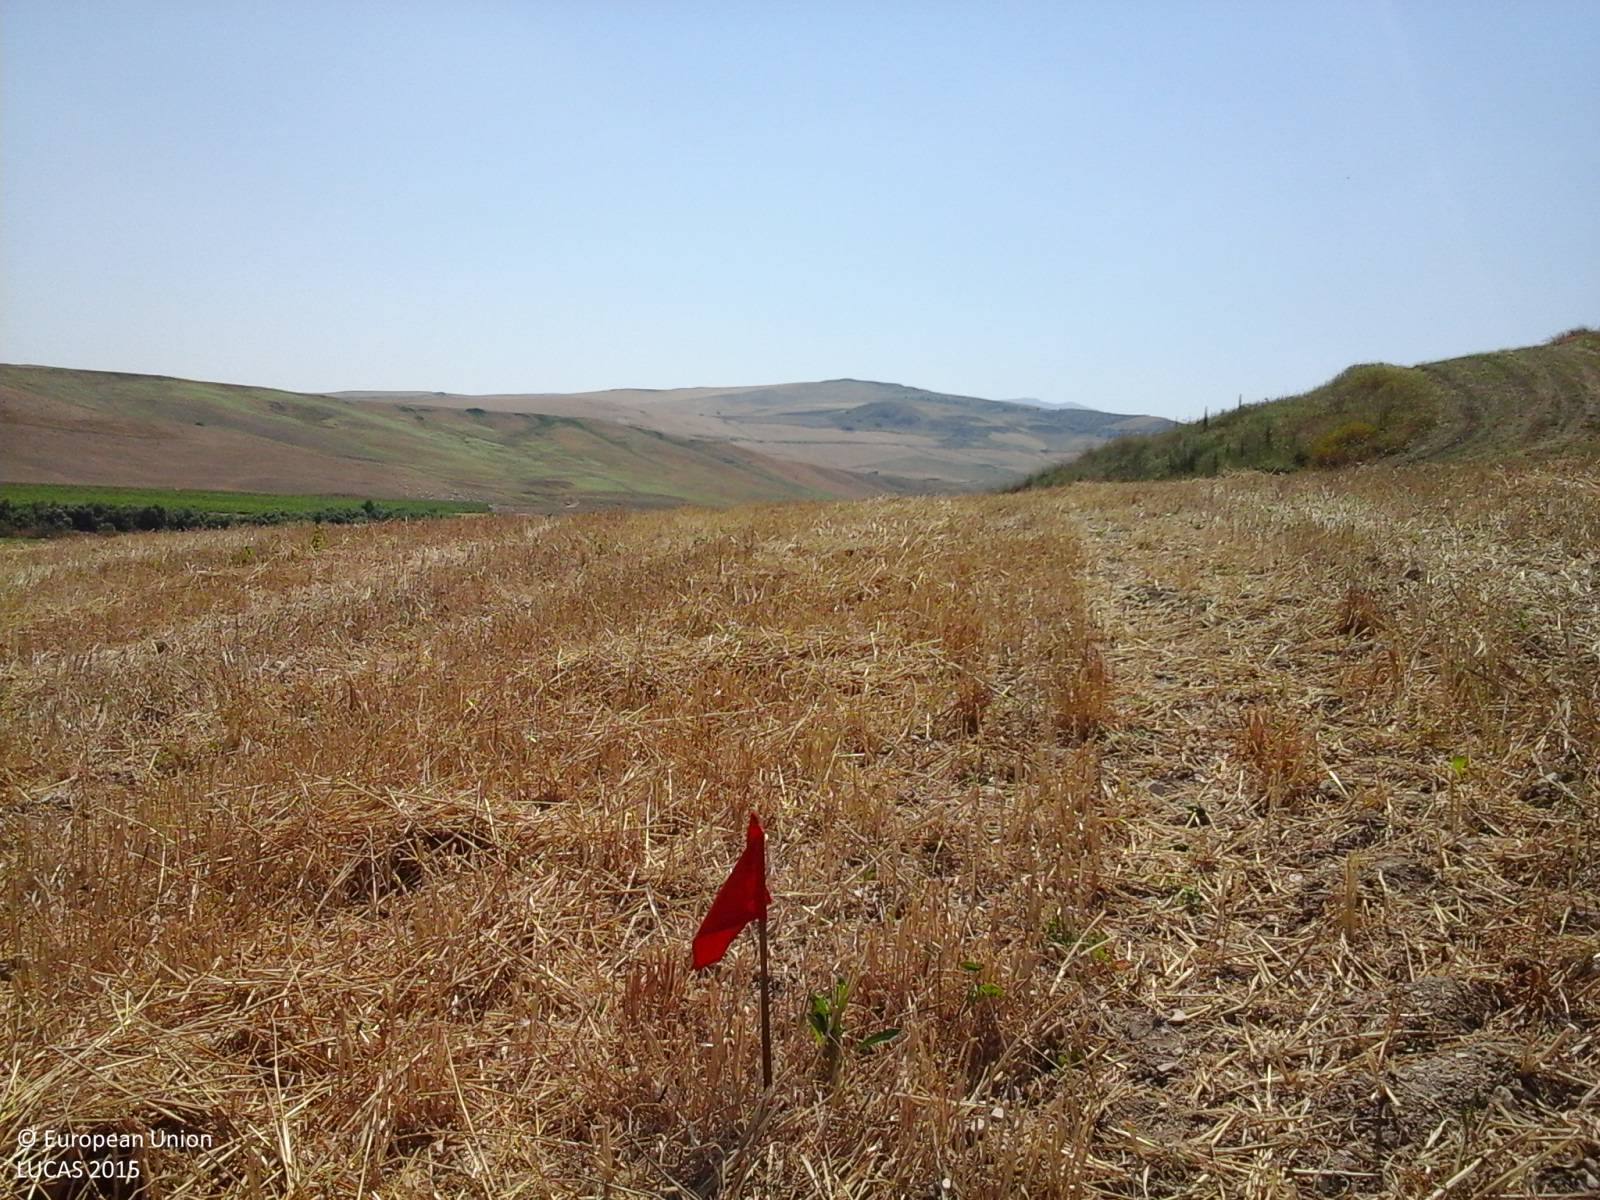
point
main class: Cropland
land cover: Durum wheat
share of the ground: > 75 %
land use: Agriculture (excluding fallow land and kitchen gardens)
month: July
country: IT
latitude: 37.8038
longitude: 13.1682
